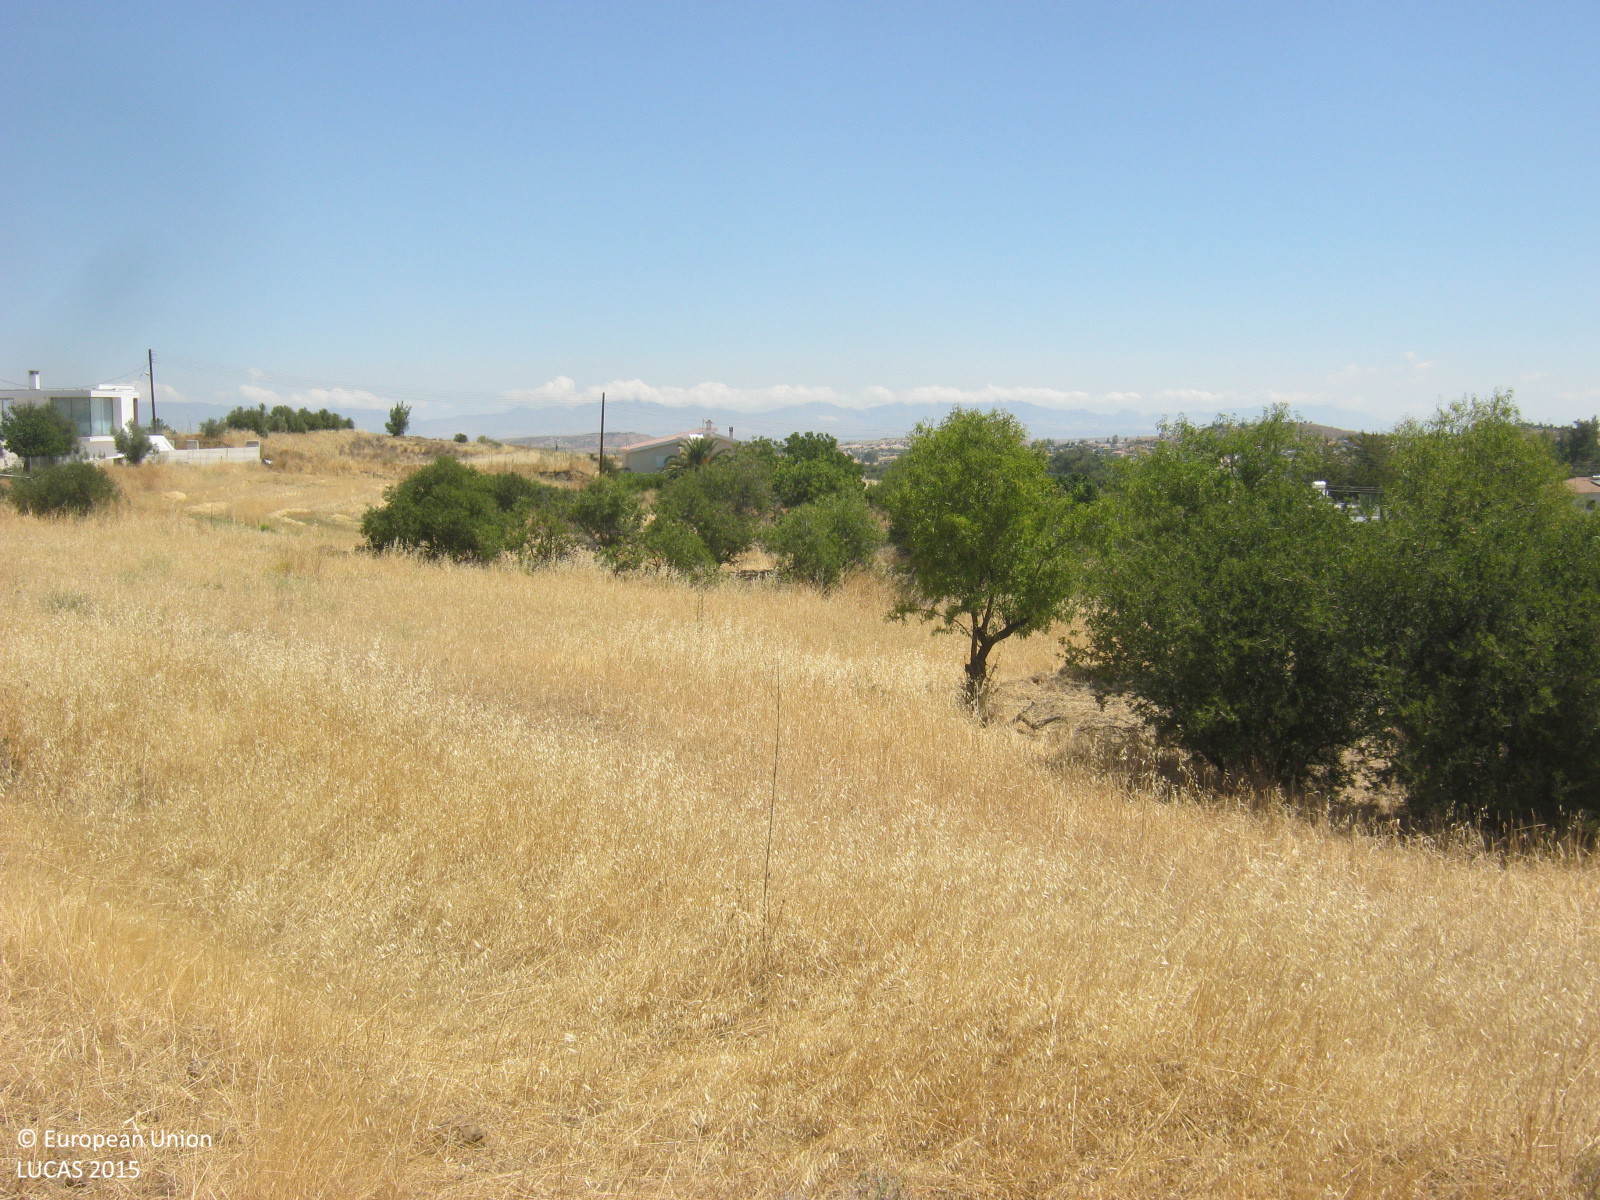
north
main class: Cropland
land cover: Nuts trees
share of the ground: 25 - 50 %
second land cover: Spontaneously vegetated surfaces
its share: 10 - 25 %
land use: Agriculture (excluding fallow land and kitchen gardens)
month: June
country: CY
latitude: 35.0152
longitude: 33.1613
